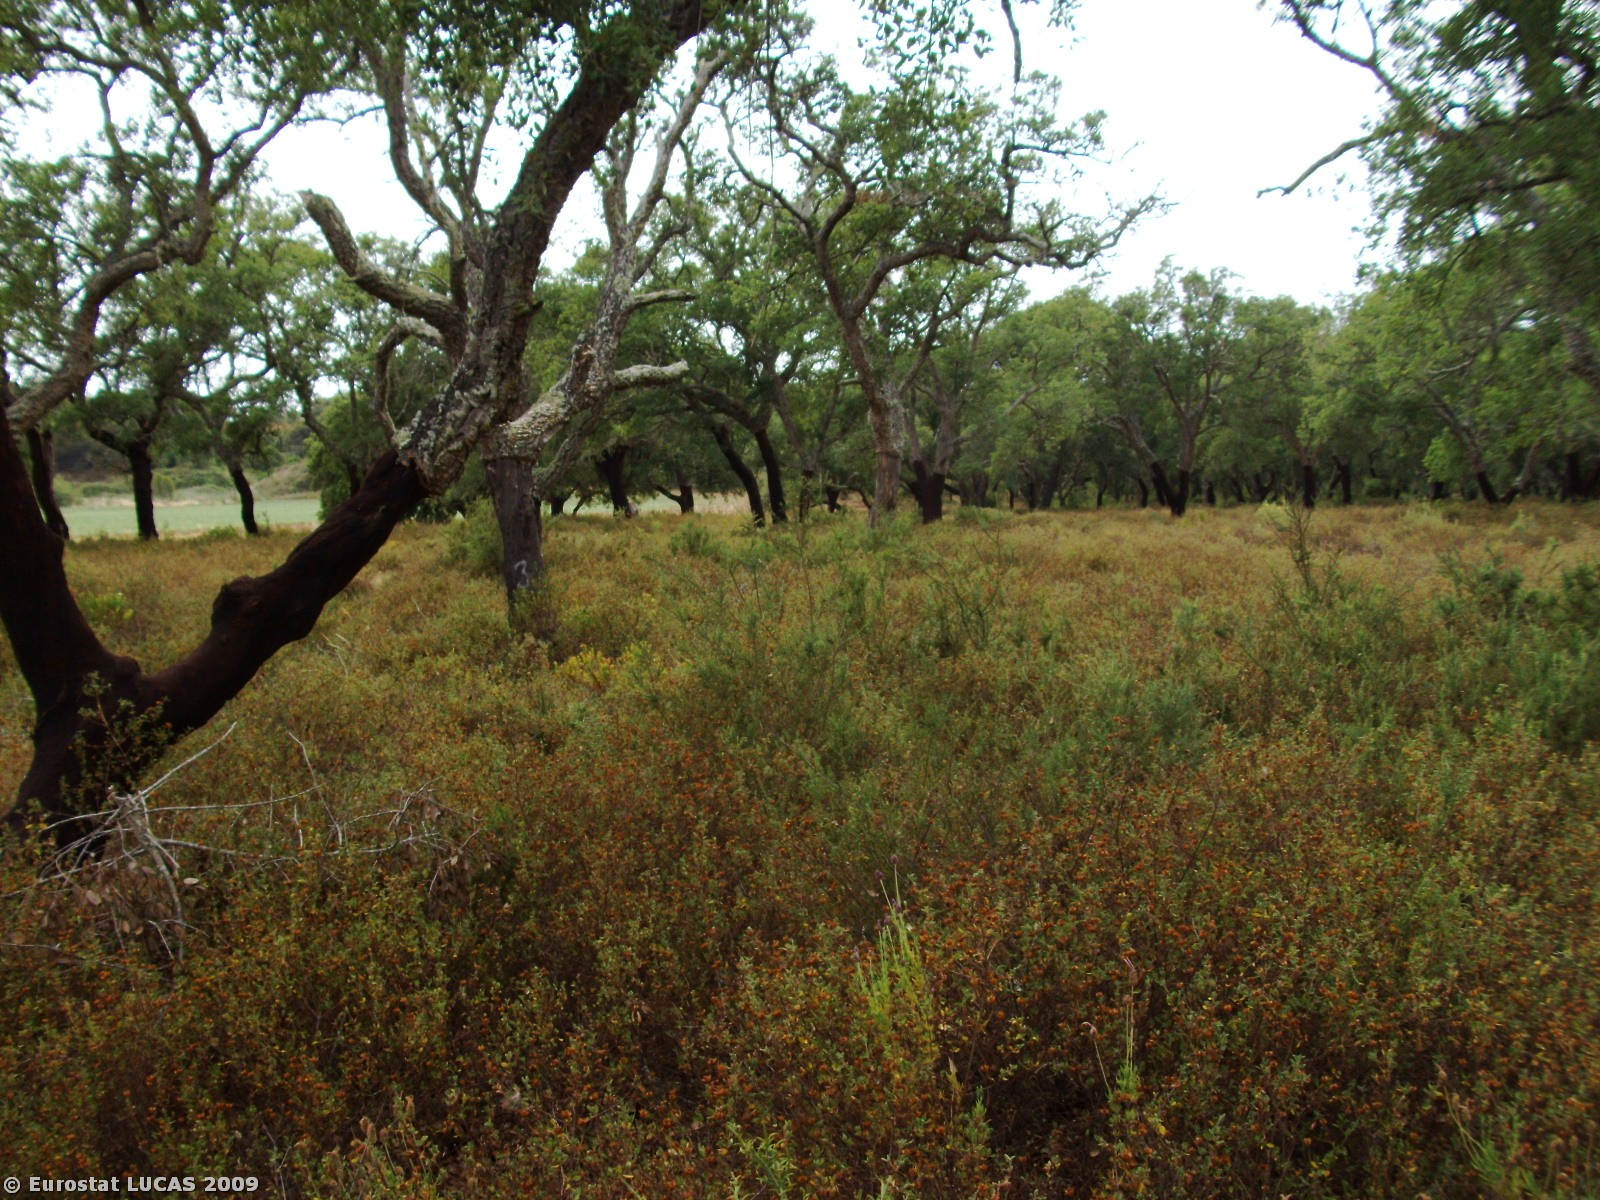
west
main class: Woodland
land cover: Broadleaved woodland
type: broadleaved evergreen forest
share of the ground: 10 - 25 %
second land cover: Shrubland with sparse tree cover
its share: 50 - 75 %
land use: Forestry
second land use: Unused
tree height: > 5 m
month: June
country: PT
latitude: 38.0564
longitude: -8.7293
